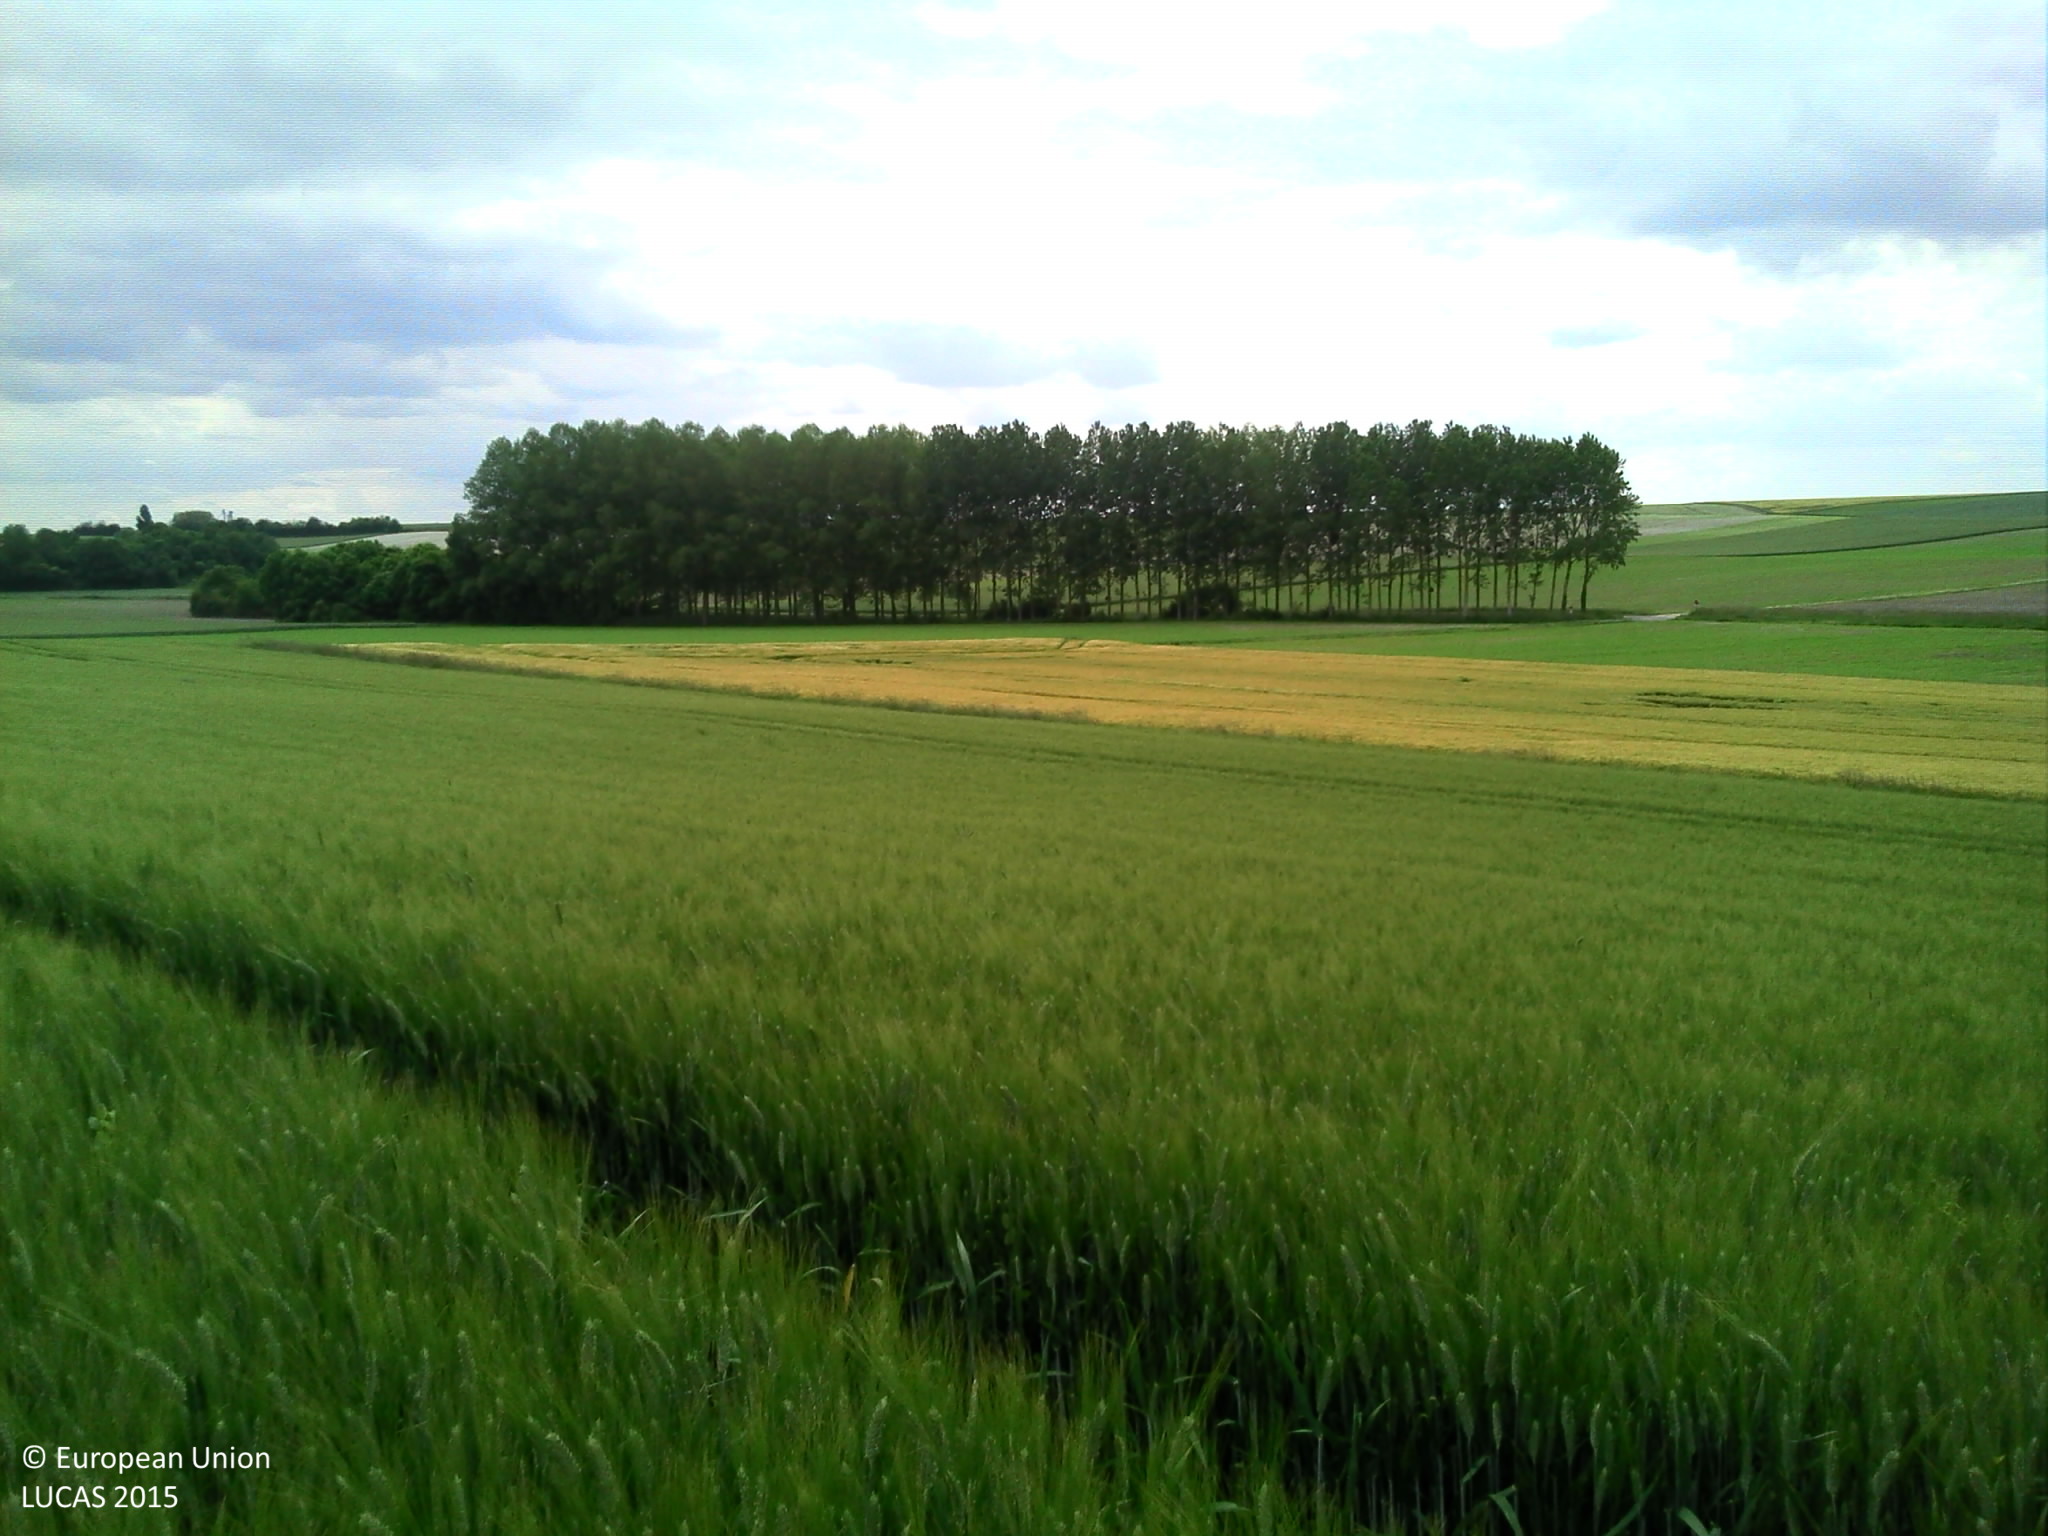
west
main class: Cropland
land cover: Durum wheat
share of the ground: > 75 %
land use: Agriculture (excluding fallow land and kitchen gardens)
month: May
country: FR
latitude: 46.8084
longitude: 0.2161
